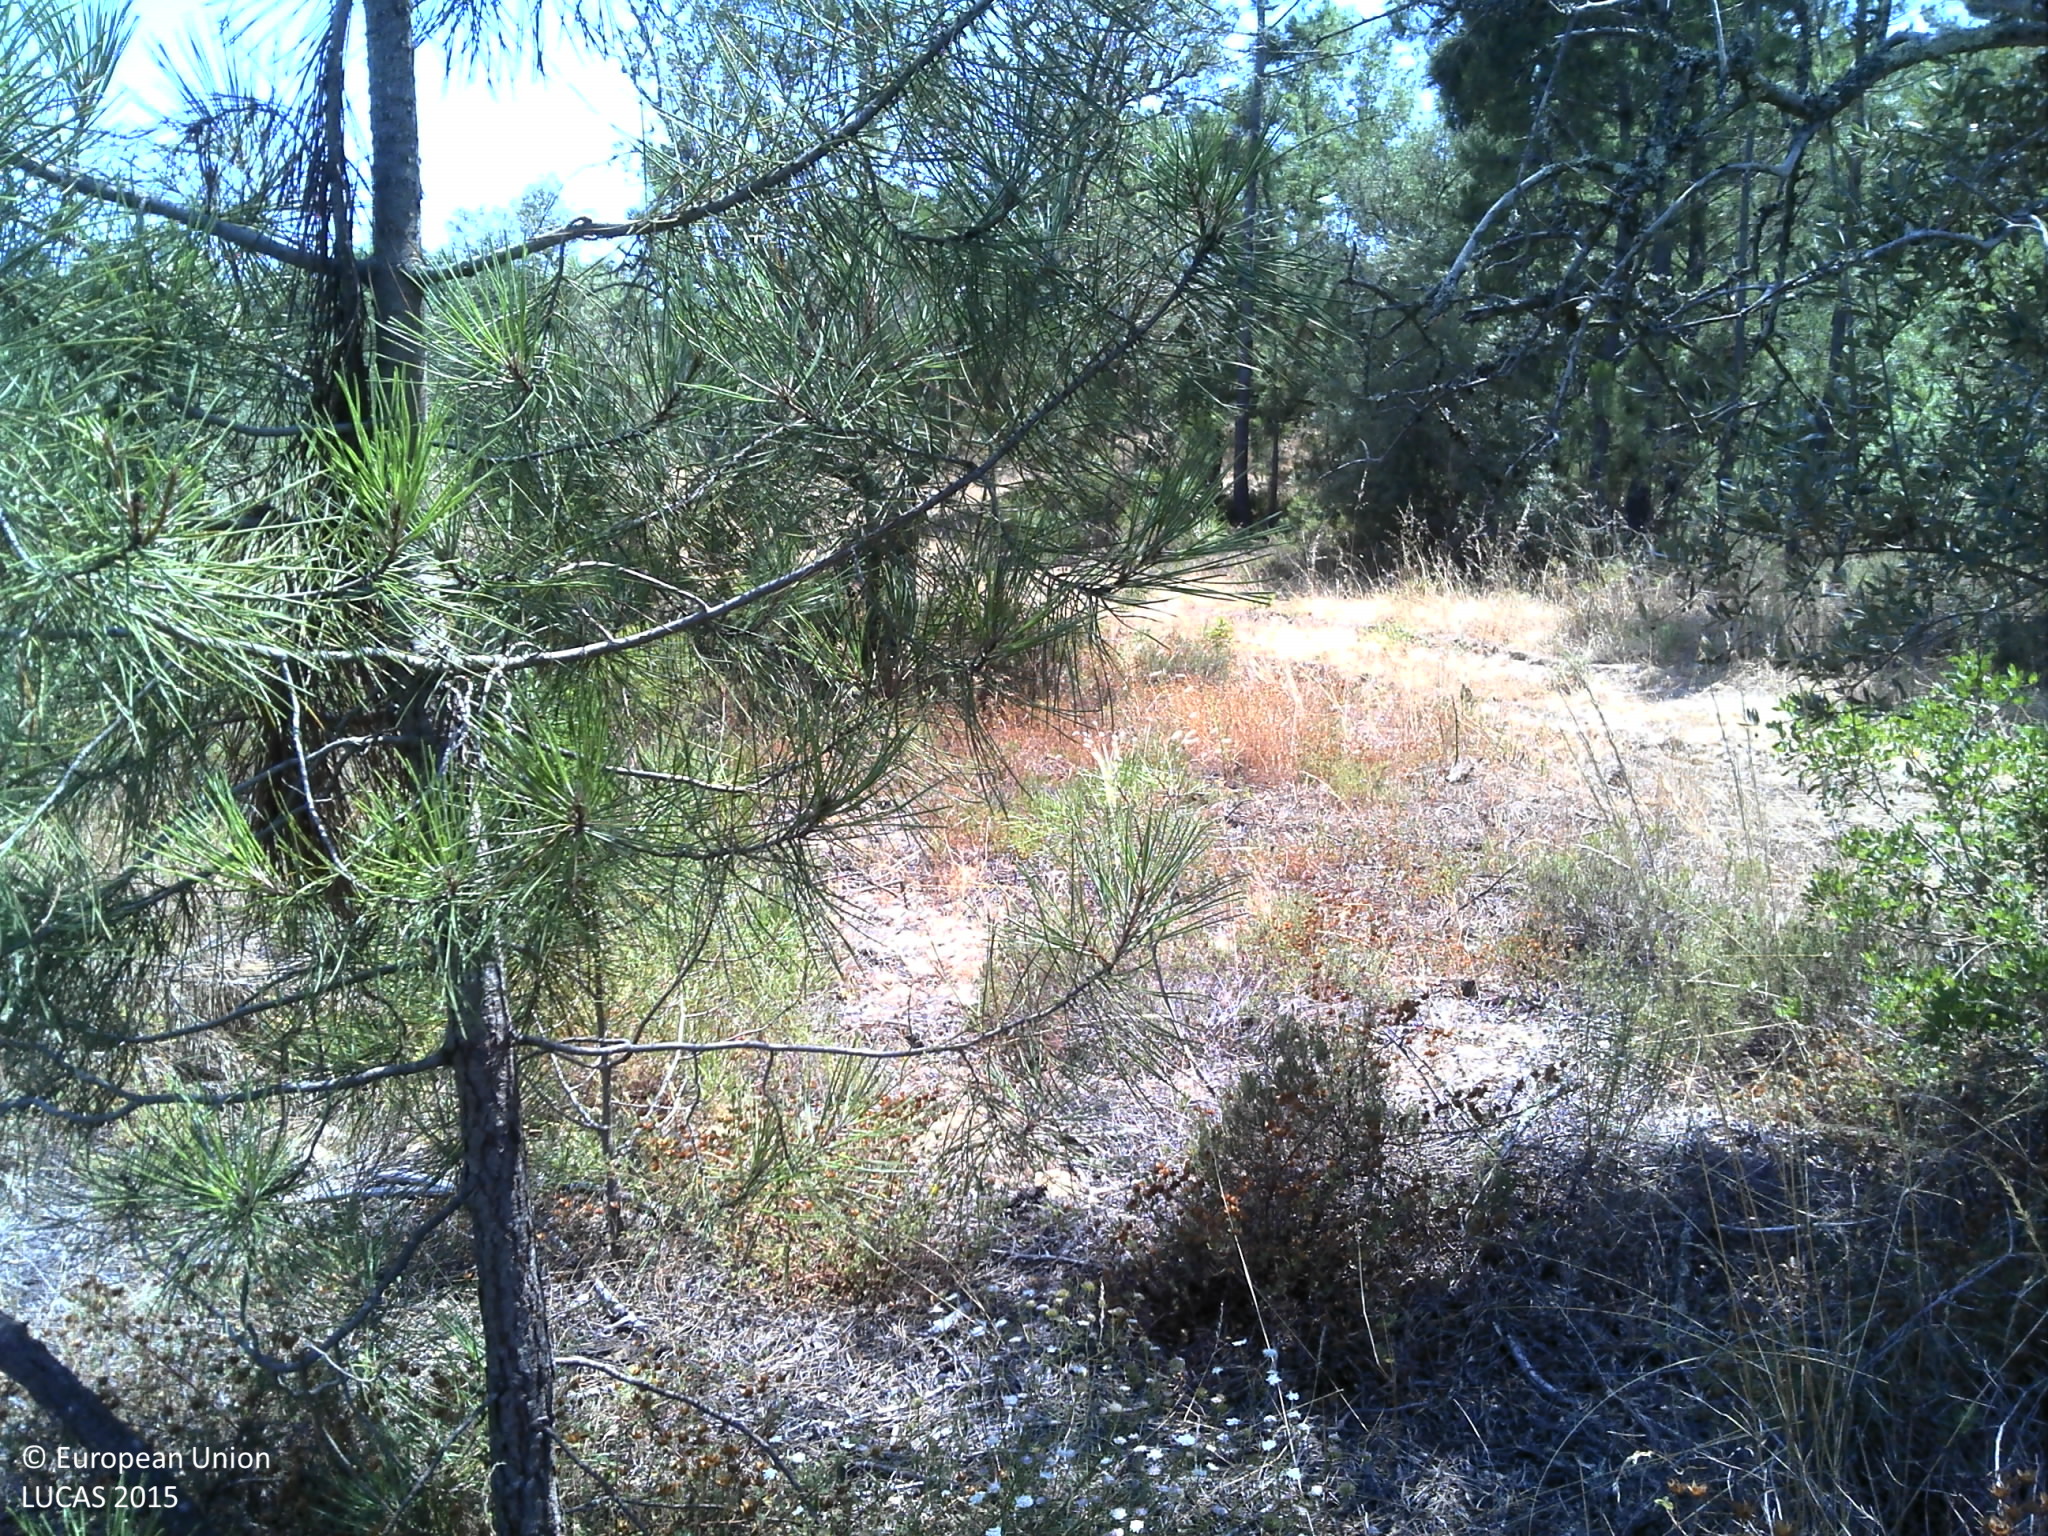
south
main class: Woodland
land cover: Pine dominated coniferous woodland
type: coniferous forest of the mediterranean region
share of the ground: 25 - 50 %
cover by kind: coniferous forest trees 35 %, unconsolidated bare surface 30 %, shrubs 15 %, herbaceous plants 15 %, broadleaved forest trees 5 %
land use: Forestry
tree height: > 5 m
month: June
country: PT
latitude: 38.4892
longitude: -9.0652
